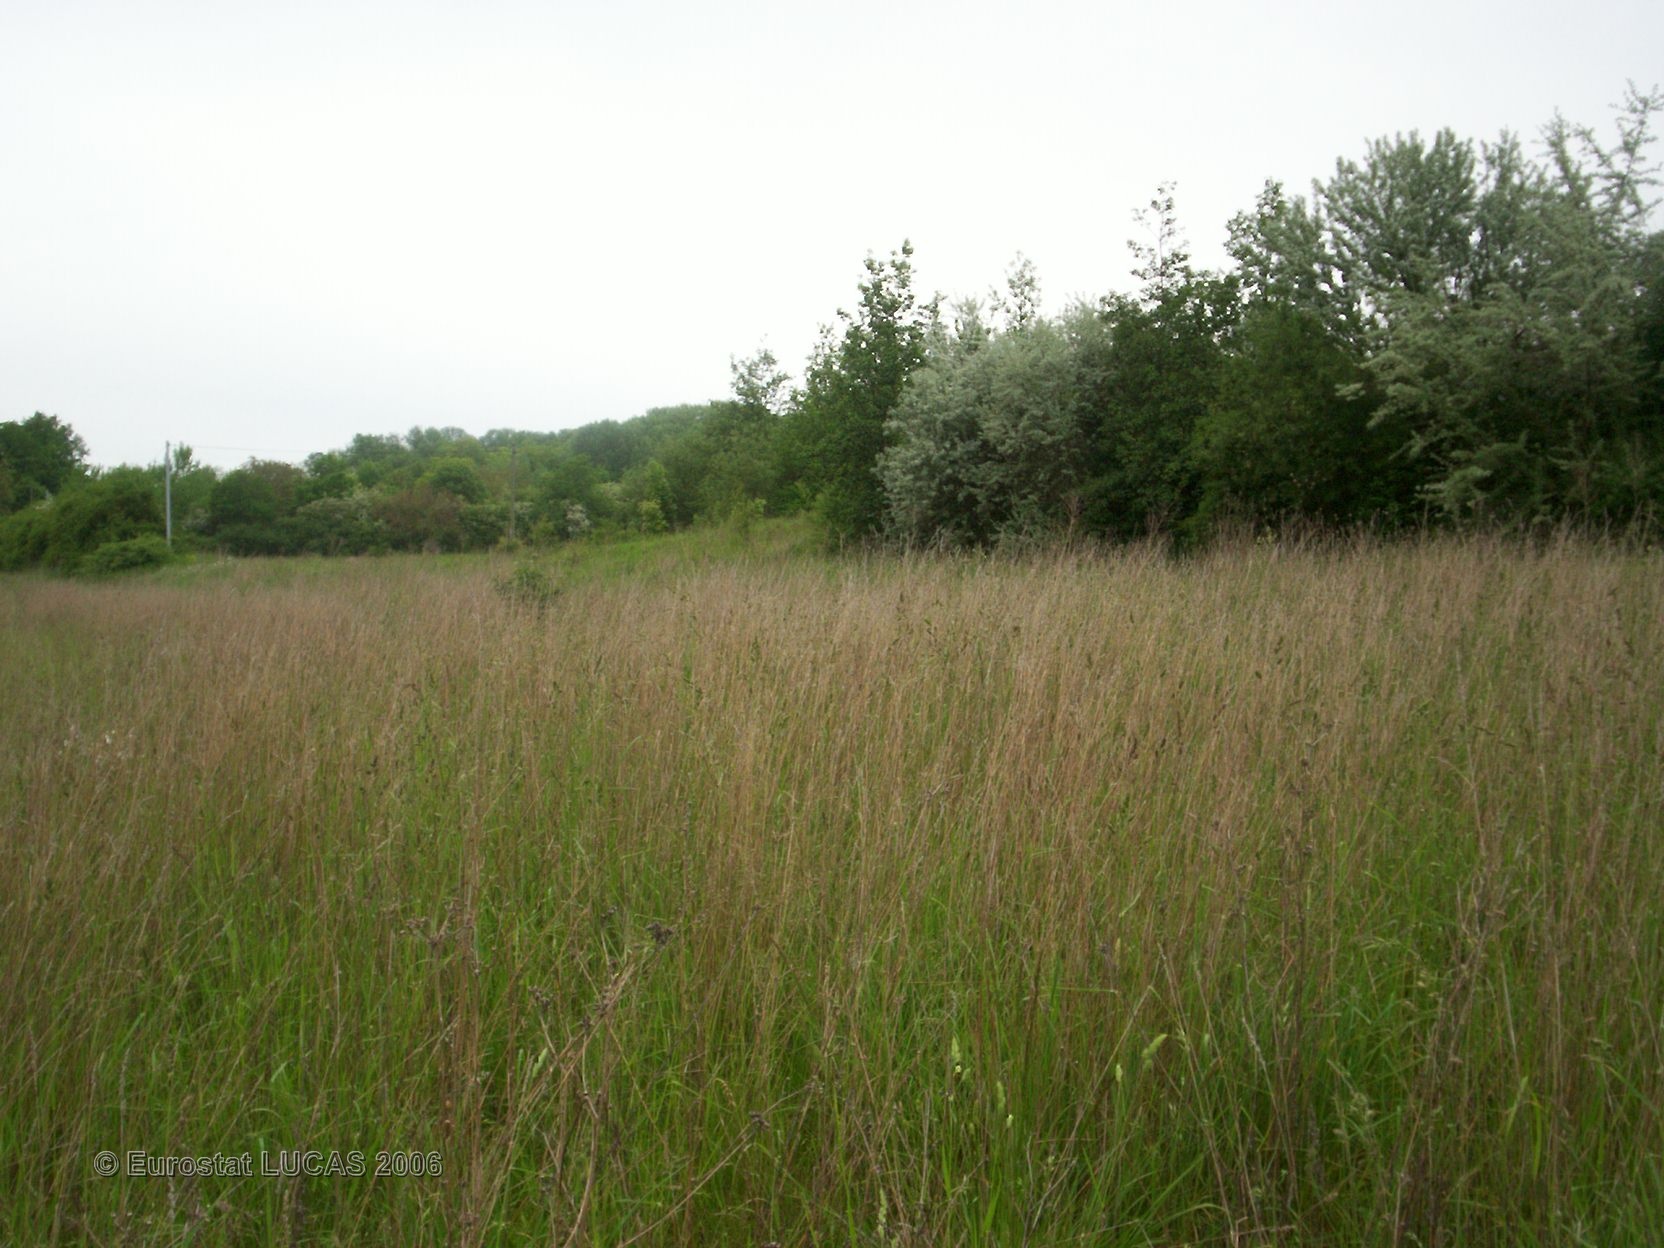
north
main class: Grassland
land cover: Grassland without tree/shrub cover
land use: Fallow land
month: May
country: FR
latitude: 48.6516
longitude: 2.7280
